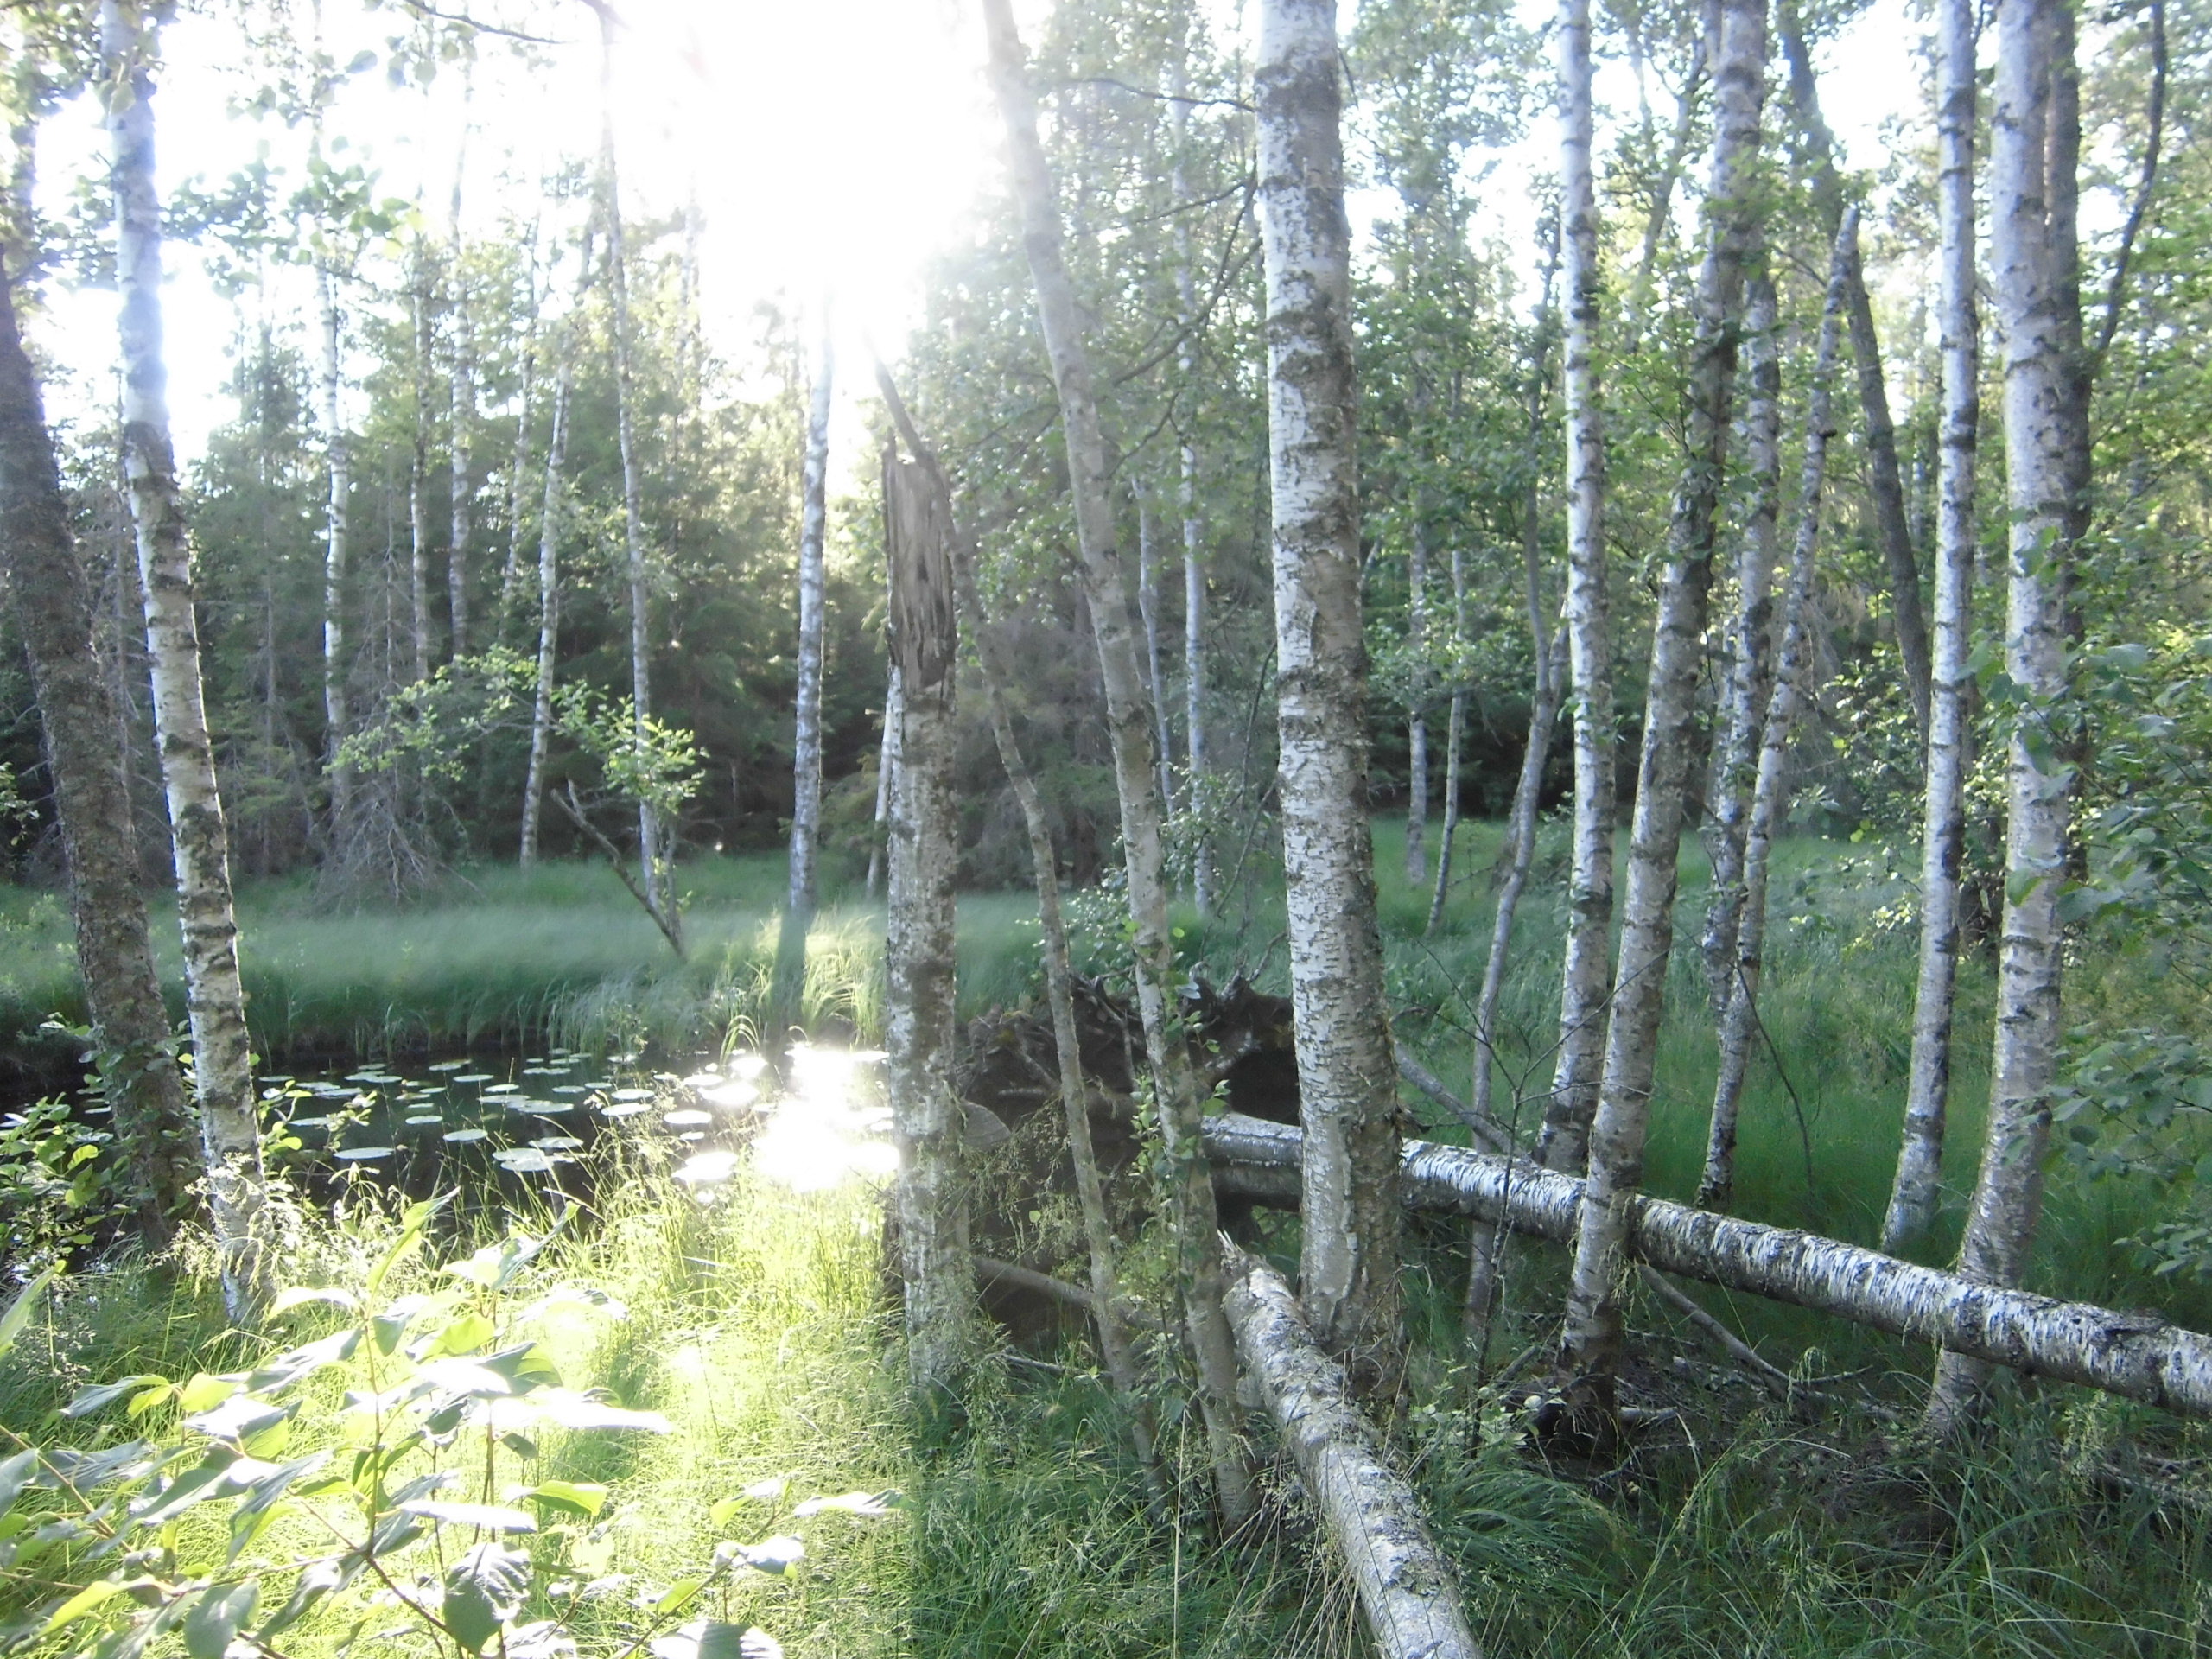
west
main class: Woodland
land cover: Pine dominated mixed woodland
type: boreal forest
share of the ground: 50 - 75 %
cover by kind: broadleaved forest trees 35 %, herbaceous plants 35 %, coniferous forest trees 25 %, shrubs 5 %
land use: Forestry
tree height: > 5 m
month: July
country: SE
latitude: 57.2464
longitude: 15.3832
